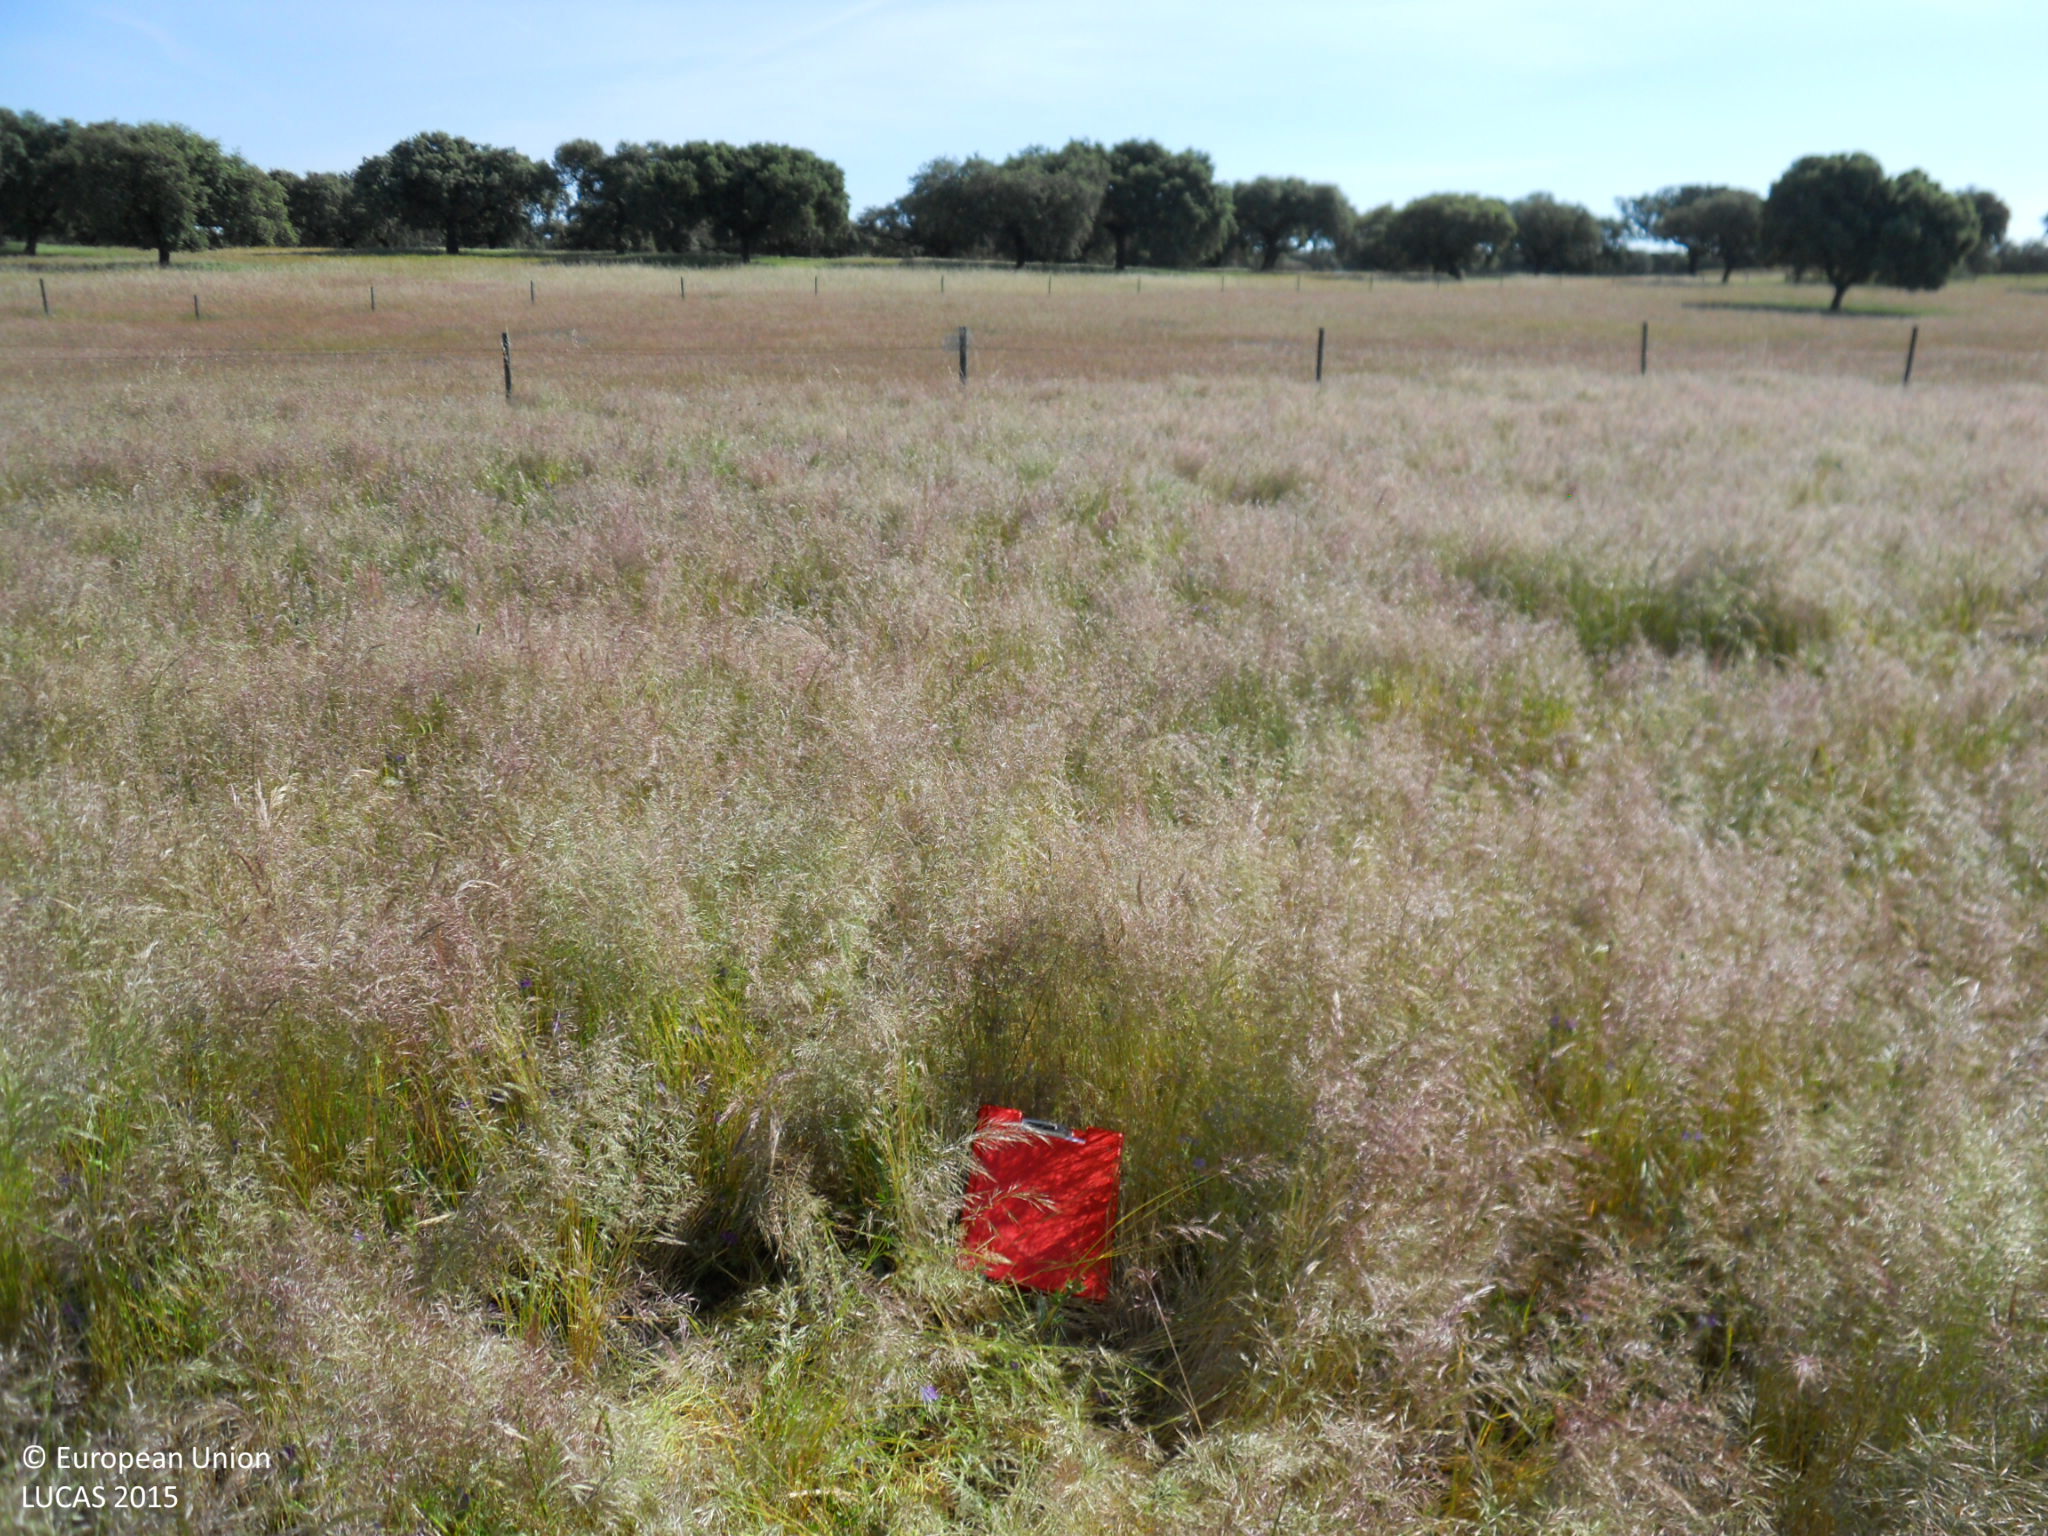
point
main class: Grassland
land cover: Grassland with sparse tree/shrub cover
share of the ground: > 75 %
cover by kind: herbaceous plants 95 %, broadleaved forest trees 5 %
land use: Agriculture (excluding fallow land and kitchen gardens)
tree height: > 5 m
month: April
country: ES
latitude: 39.0543
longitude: -6.8609
